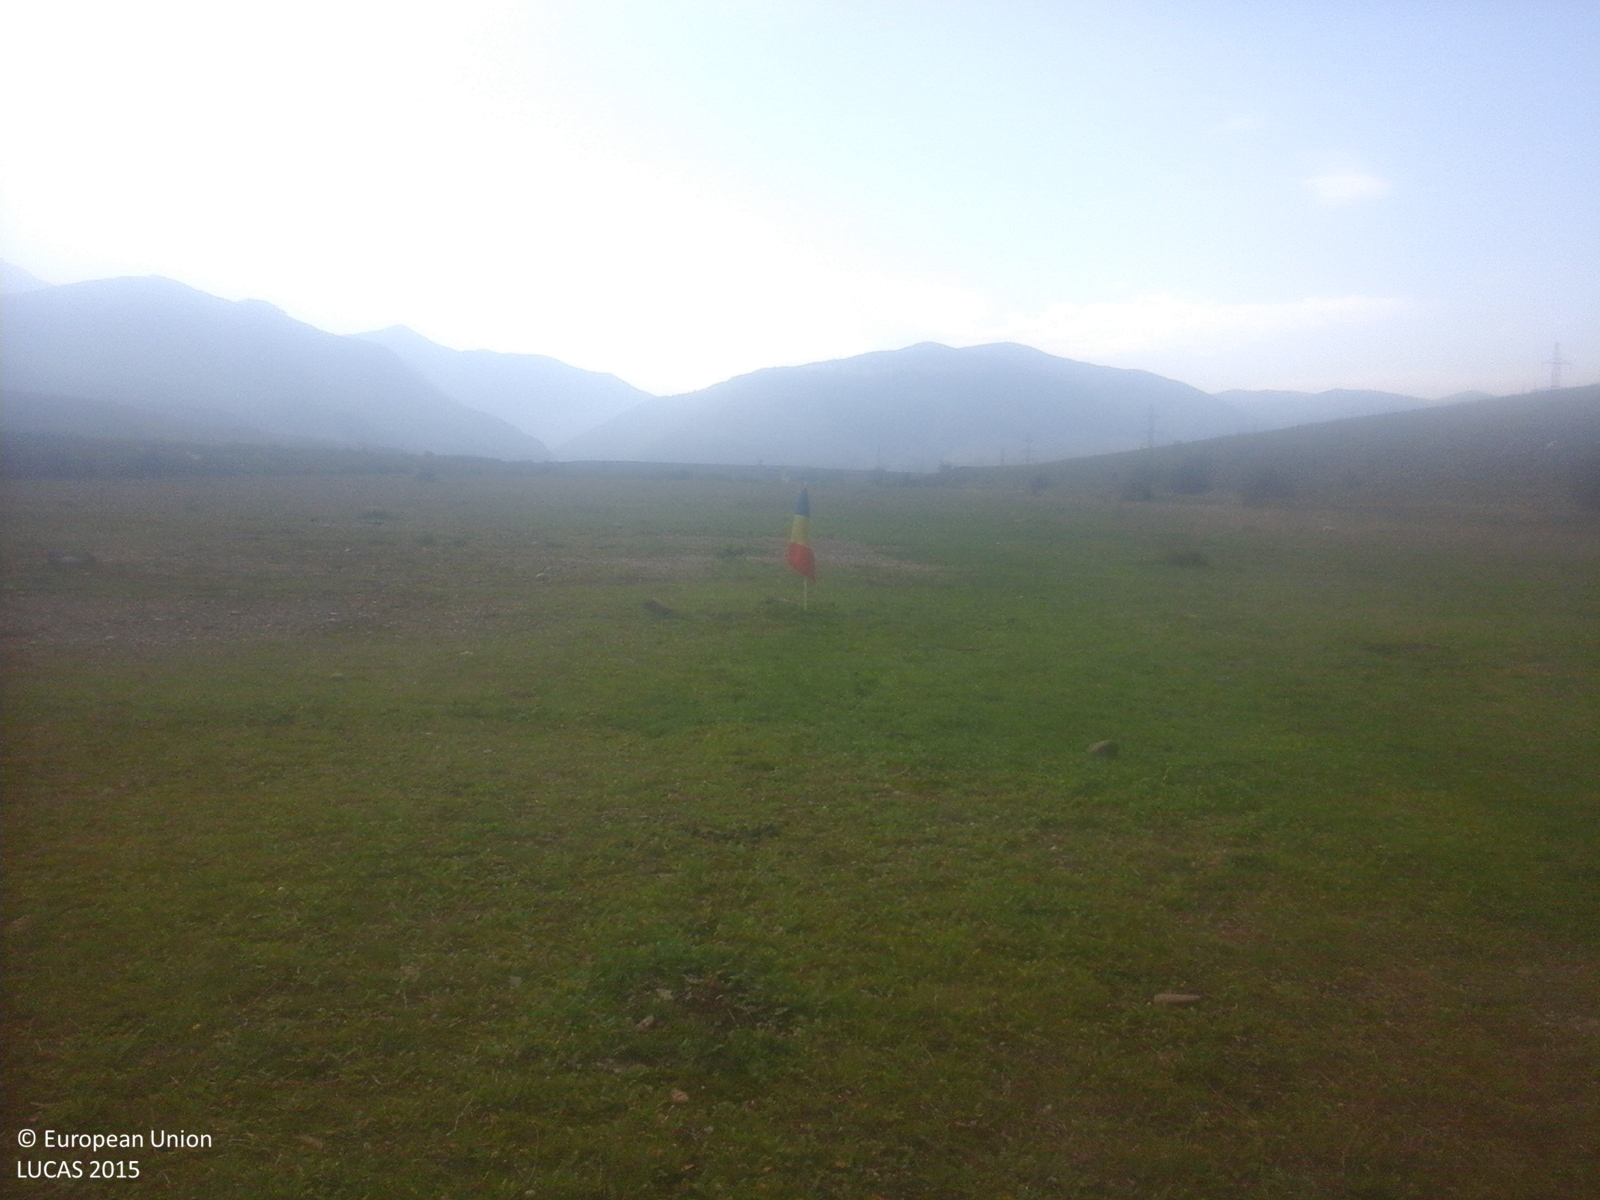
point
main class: Grassland
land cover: Grassland without tree/shrub cover
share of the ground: > 75 %
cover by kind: herbaceous plants 100 %
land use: Agriculture (excluding fallow land and kitchen gardens)
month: September
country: RO
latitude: 45.5336
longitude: 22.8691
